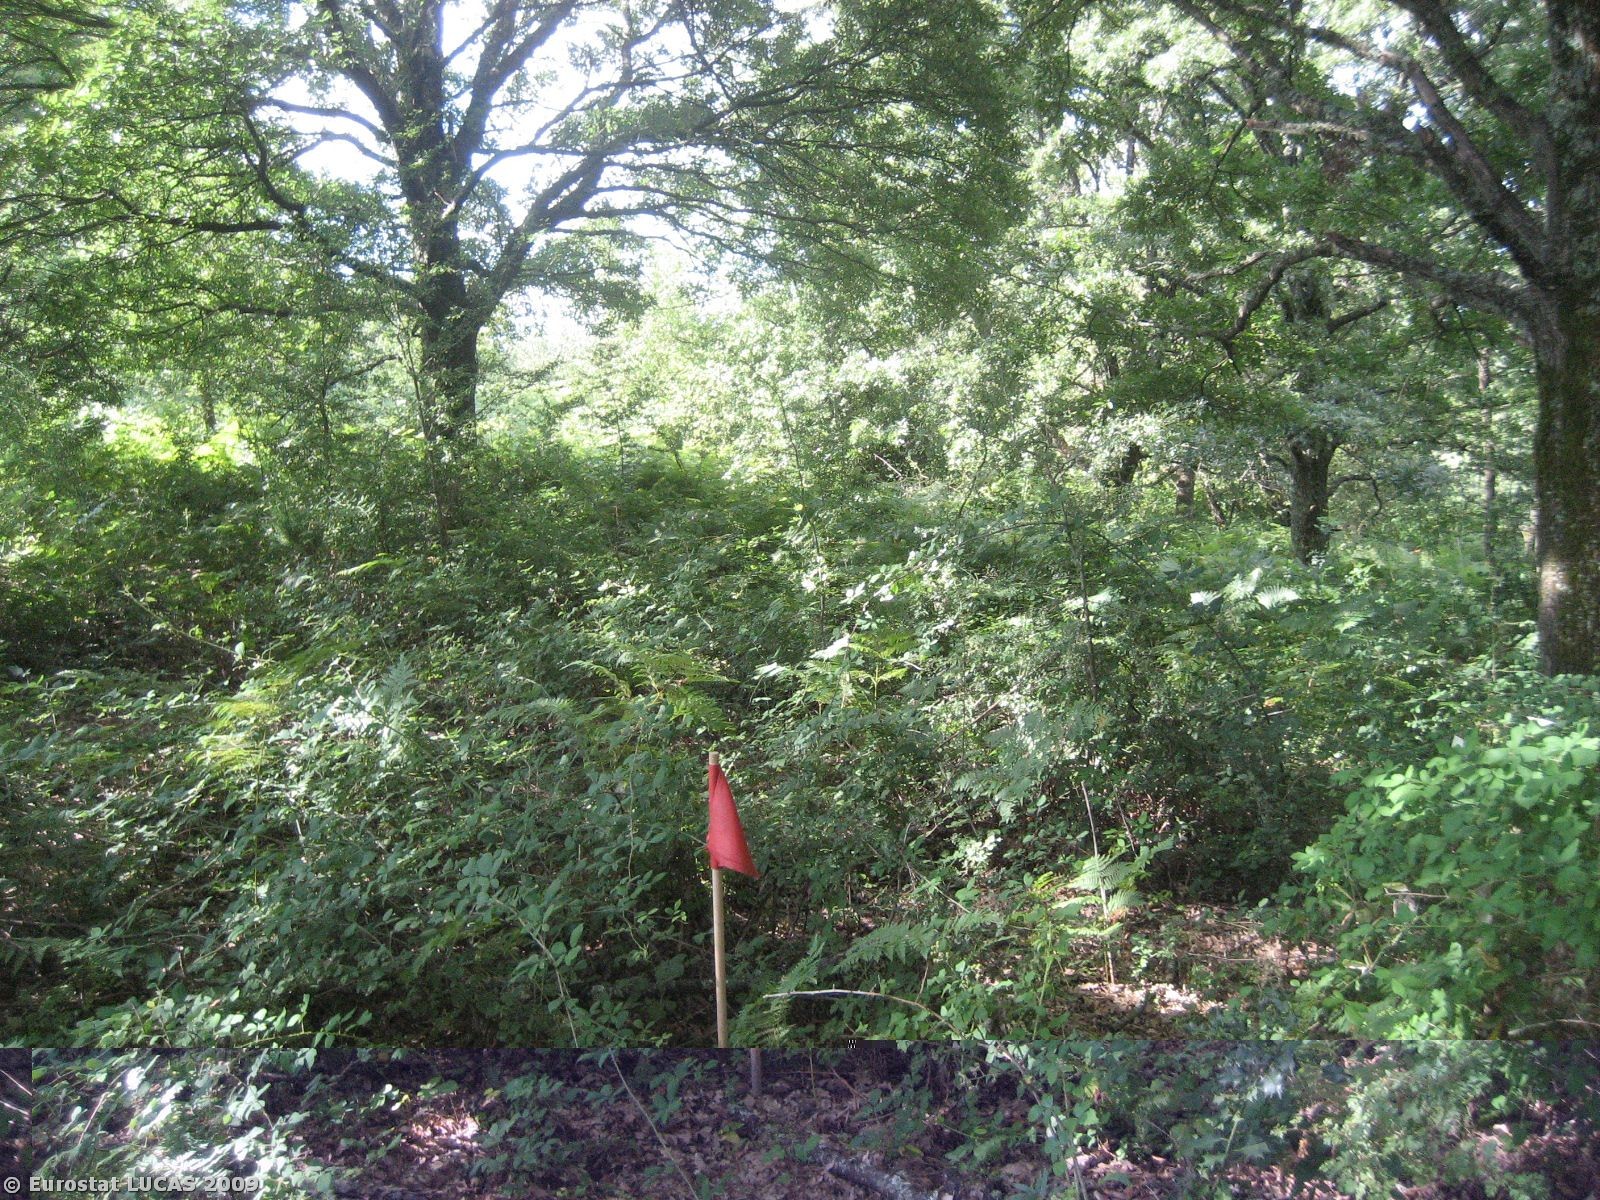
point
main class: Woodland
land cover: Broadleaved woodland
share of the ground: > 75 %
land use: Nature reserves
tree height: < 5 m
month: July
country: IT
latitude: 41.8455
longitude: 15.9449
